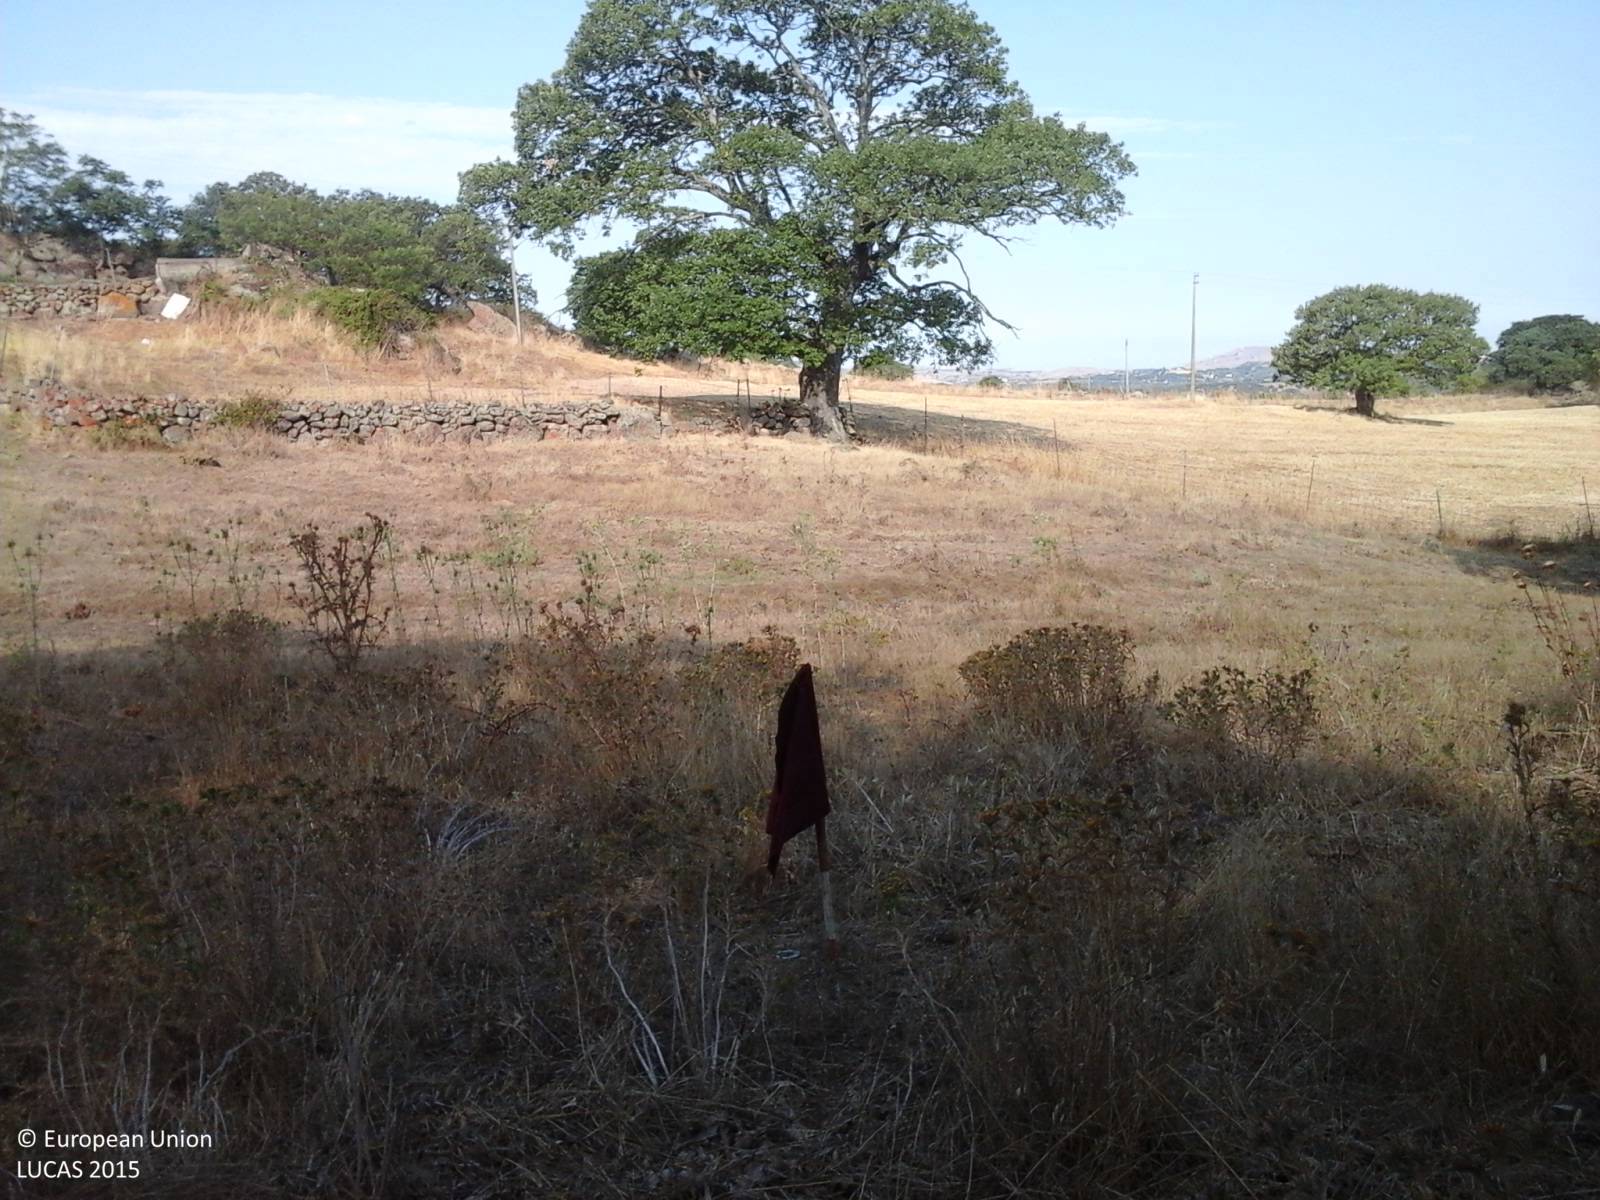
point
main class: Grassland
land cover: Grassland without tree/shrub cover
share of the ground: 50 - 75 %
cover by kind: herbaceous plants 100 %
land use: Agriculture (excluding fallow land and kitchen gardens)
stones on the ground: < 10 %
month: July
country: IT
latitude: 40.7315
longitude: 8.8806
